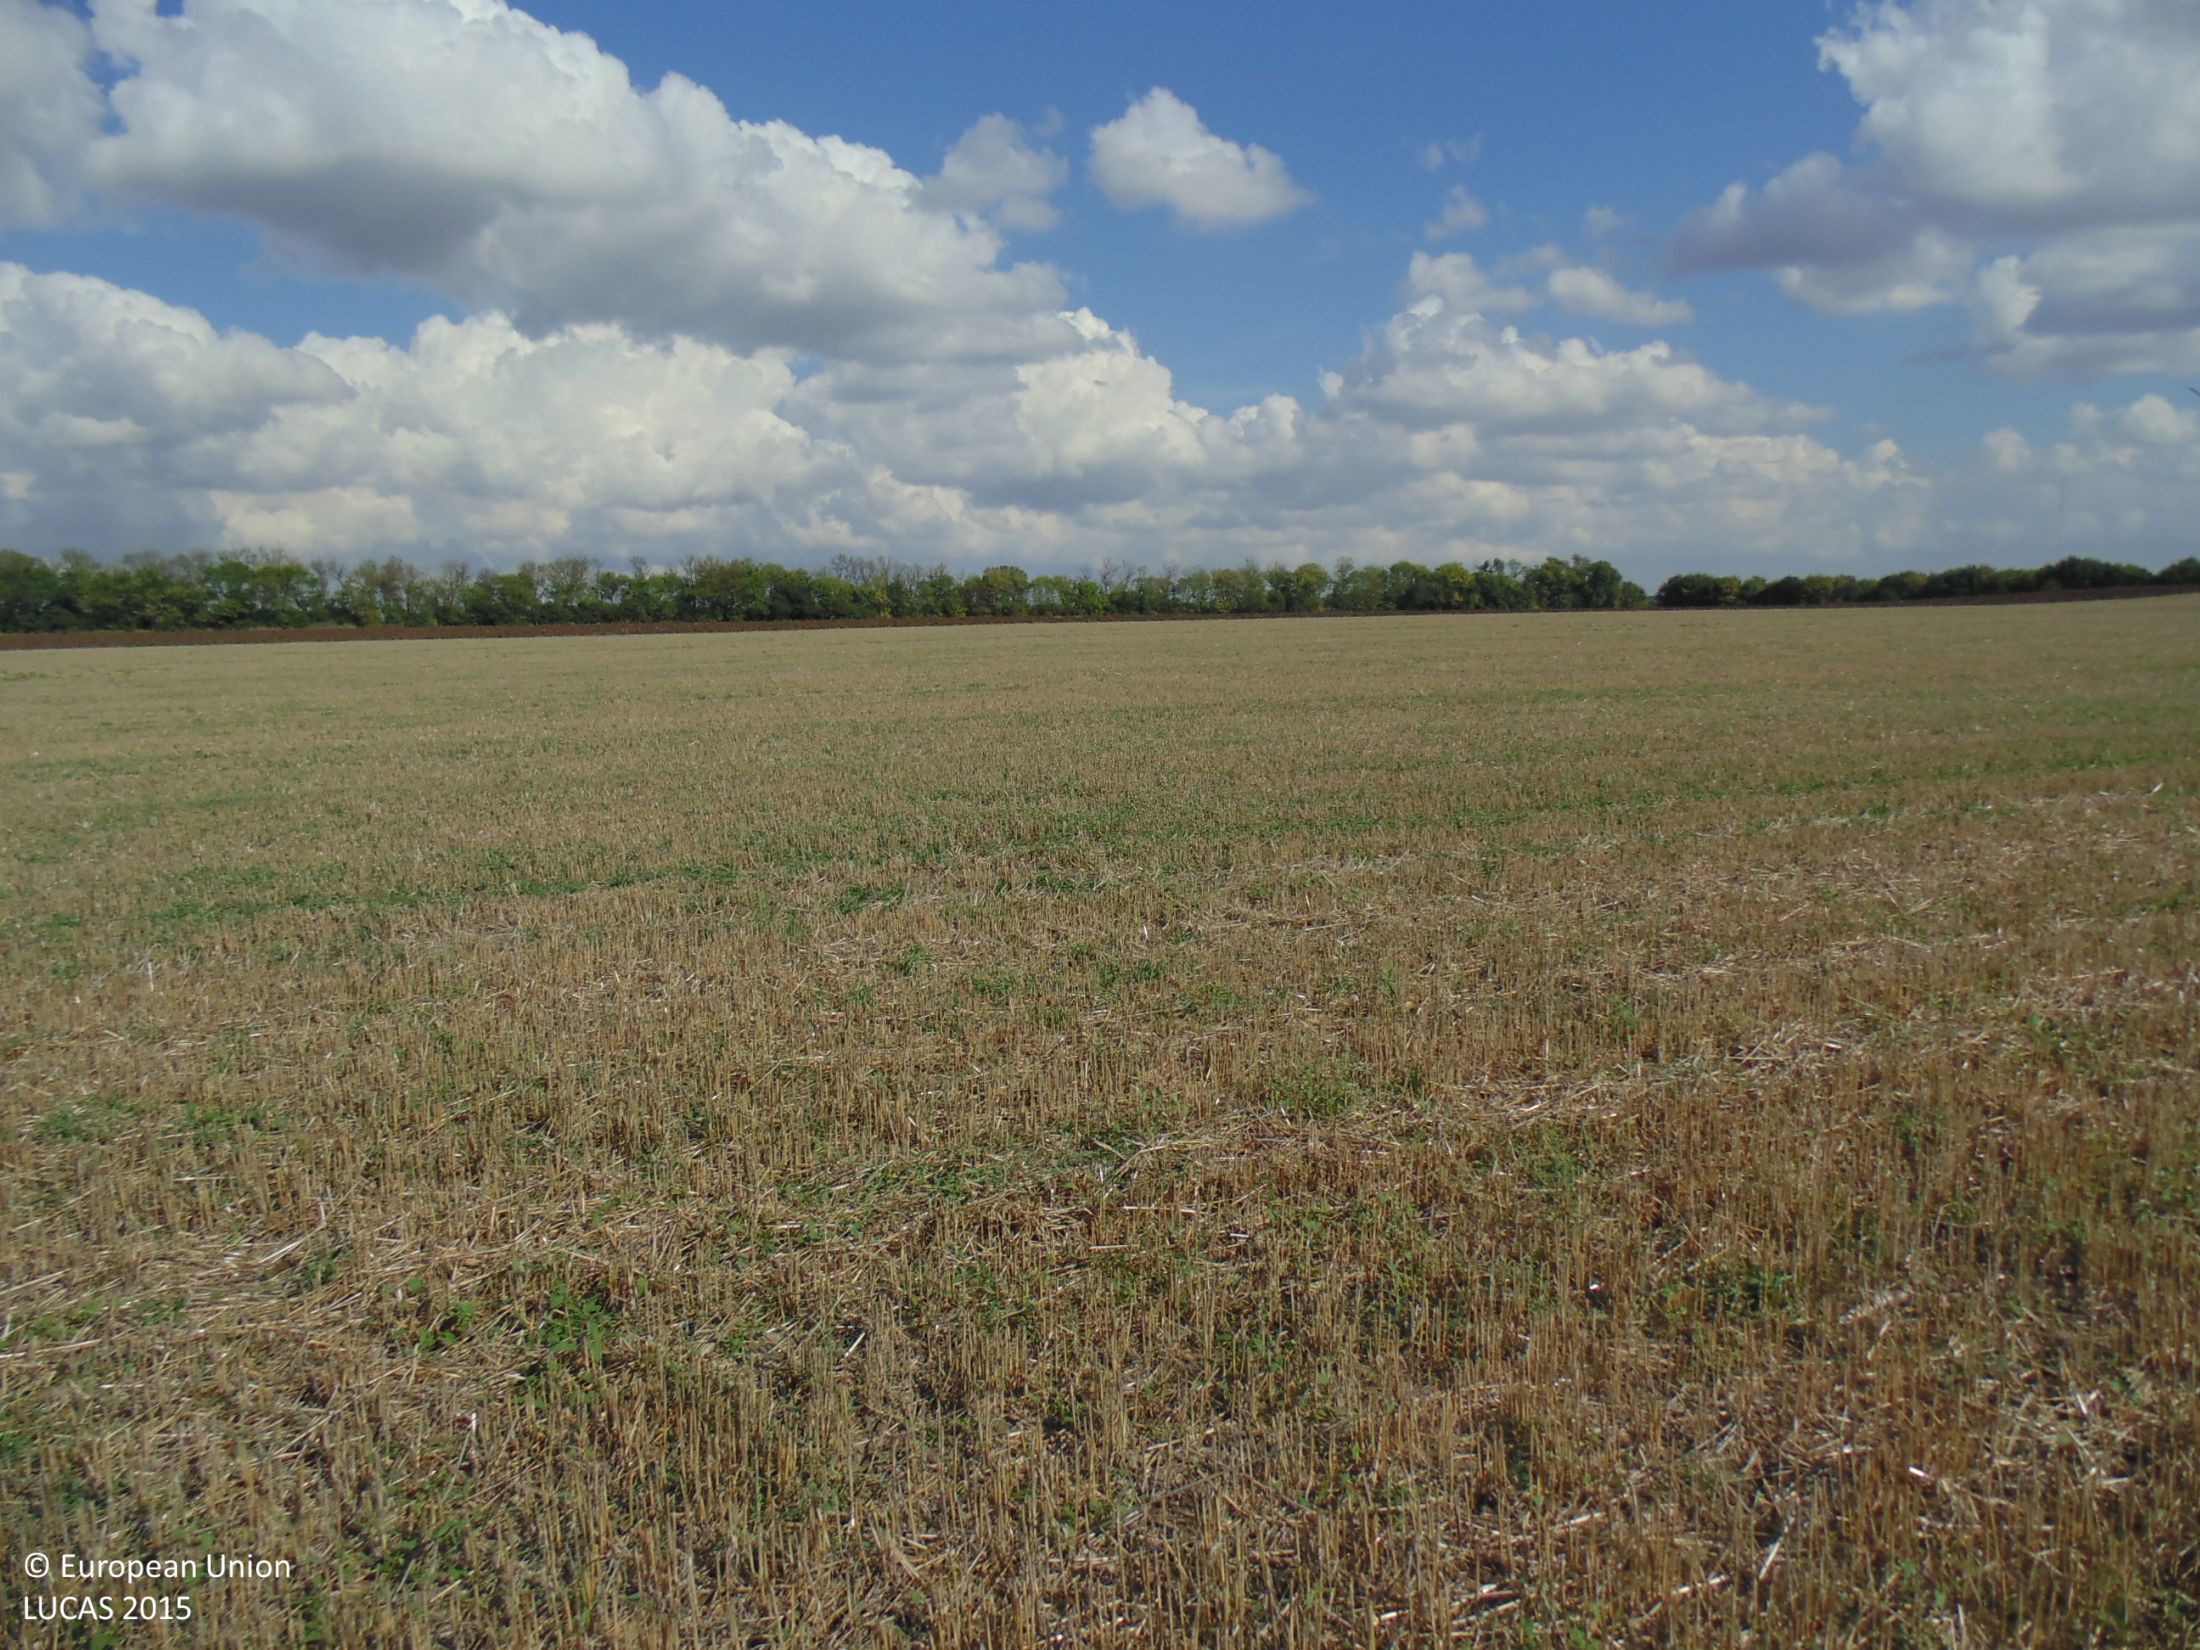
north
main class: Cropland
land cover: Common wheat
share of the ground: 25 - 50 %
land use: Agriculture (excluding fallow land and kitchen gardens)
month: September
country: BG
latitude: 43.4694
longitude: 28.4665
